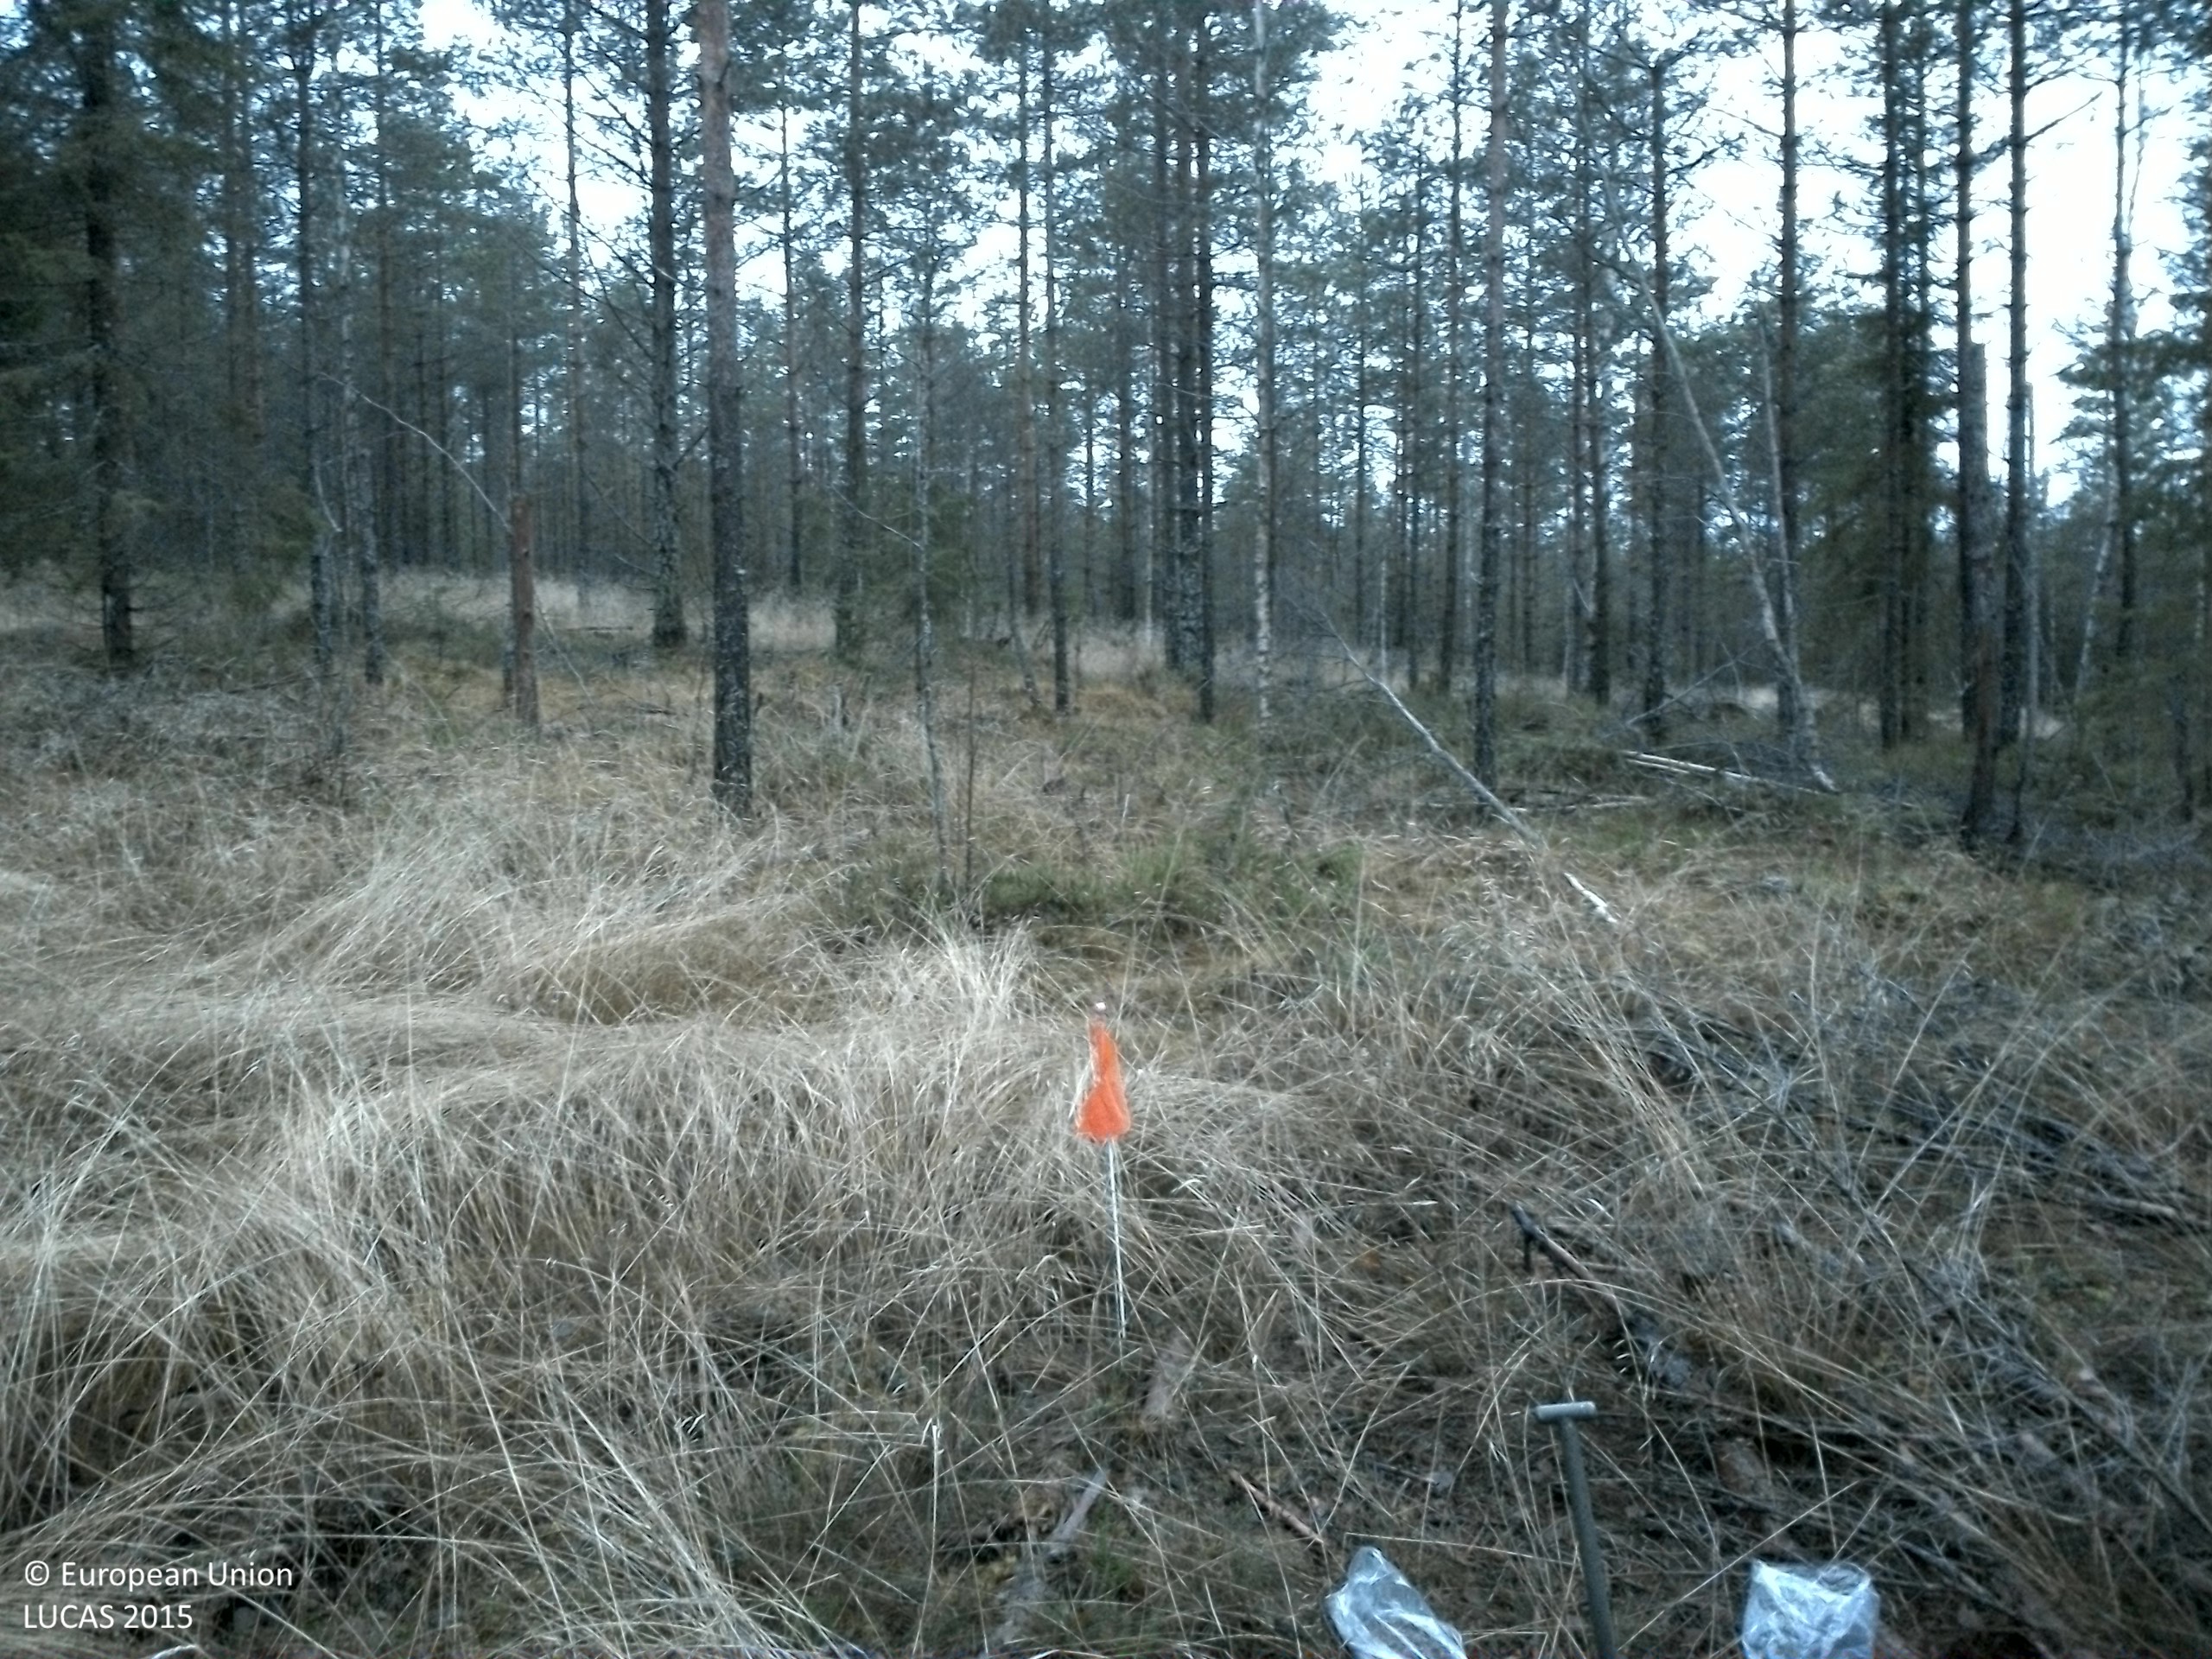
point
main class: Woodland
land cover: Pine dominated coniferous woodland
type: boreal forest
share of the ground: 25 - 50 %
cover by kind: coniferous forest trees 35 %, herbaceous plants 30 %, shrubs 20 %, lichens and mosses 10 %, broadleaved forest trees 5 %
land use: Forestry
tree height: > 5 m
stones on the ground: < 10 %
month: November
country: SE
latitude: 59.8662
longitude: 15.2579
